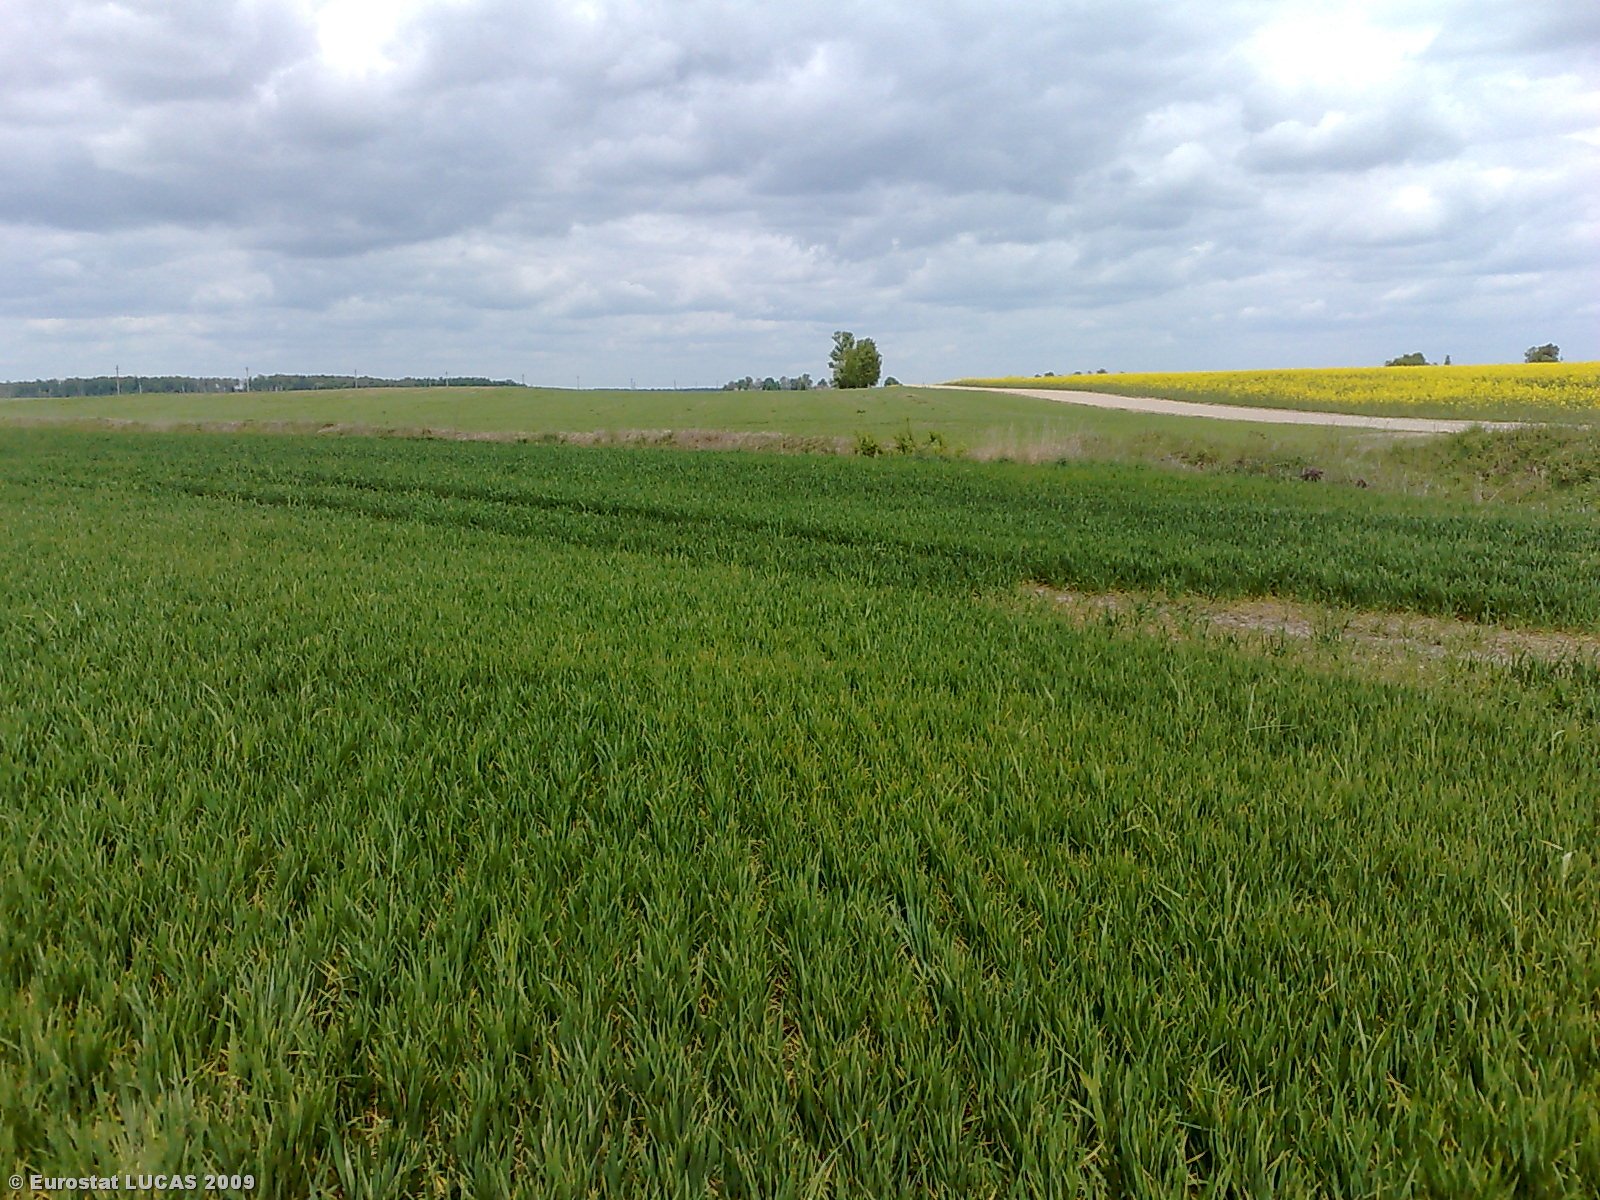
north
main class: Cropland
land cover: Common wheat
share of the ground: > 75 %
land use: Agriculture (excluding fallow land and kitchen gardens)
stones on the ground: < 10 %
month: May
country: LT
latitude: 55.6881
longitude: 23.8446
